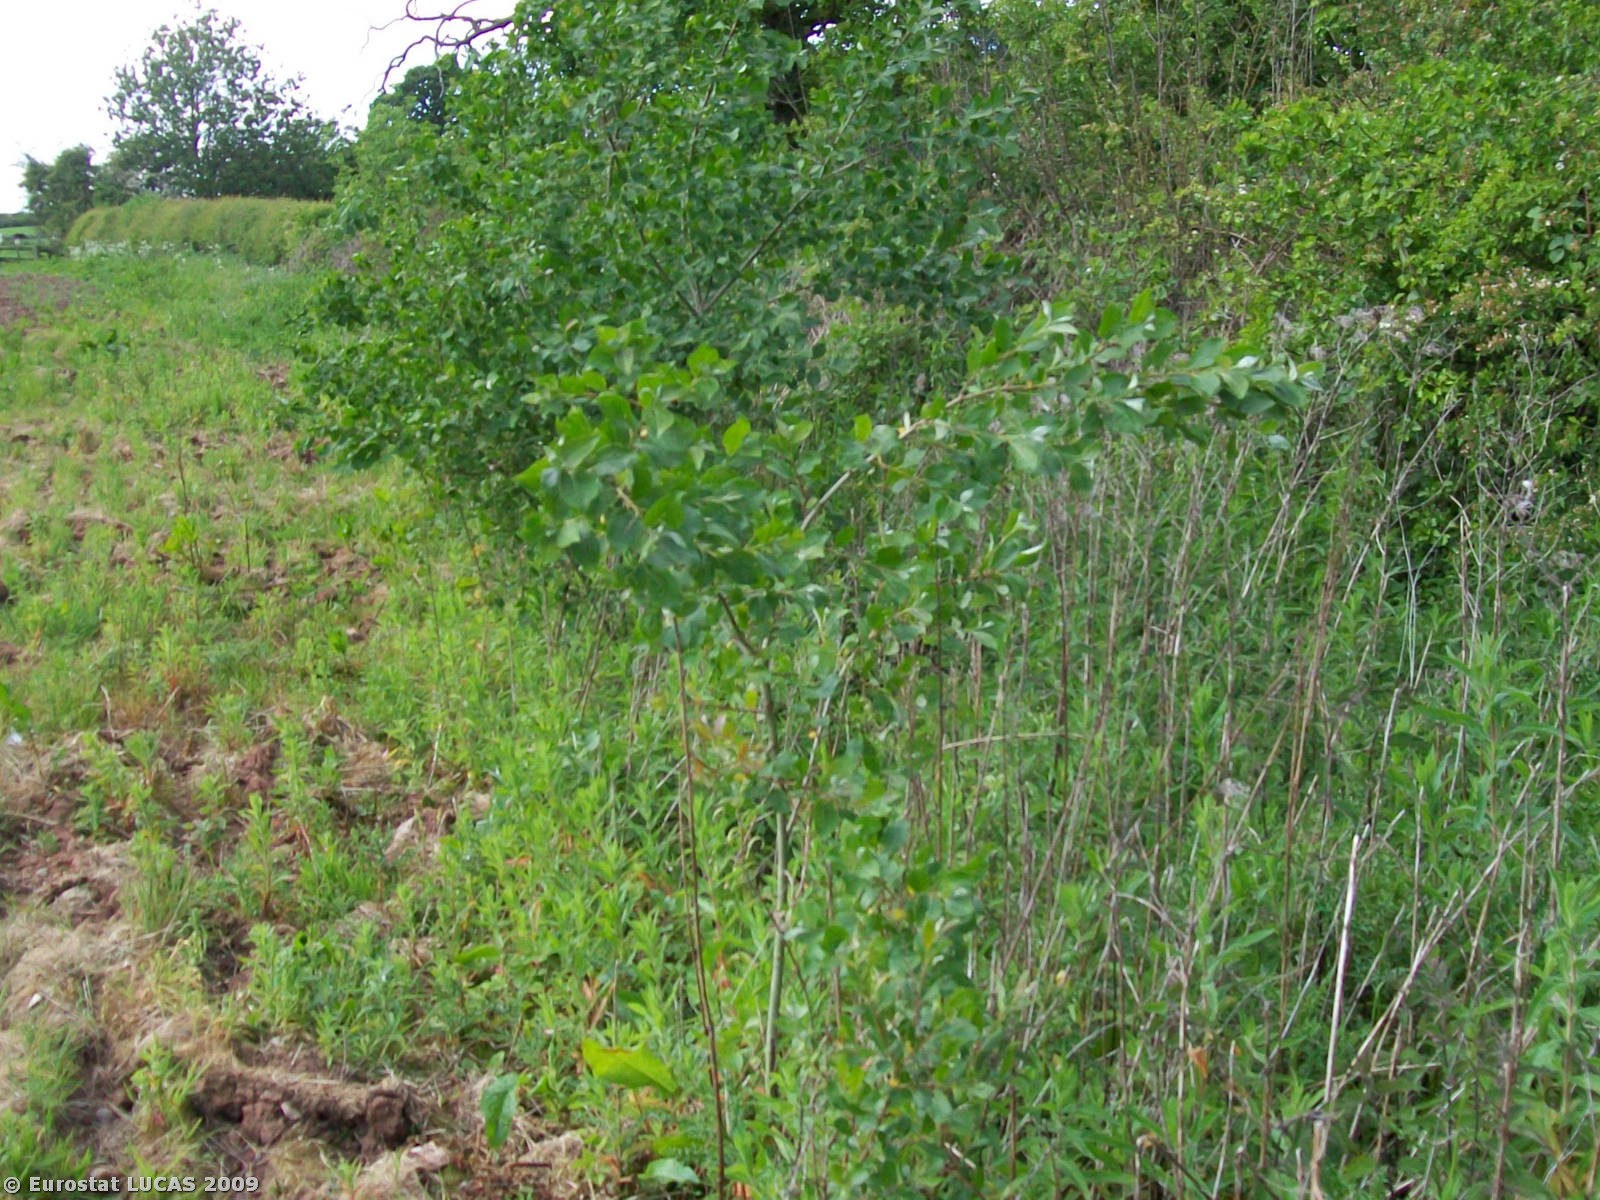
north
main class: Woodland
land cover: Broadleaved woodland
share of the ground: 25 - 50 %
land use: Unused
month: May
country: GB
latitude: 52.8118
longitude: -1.1583
